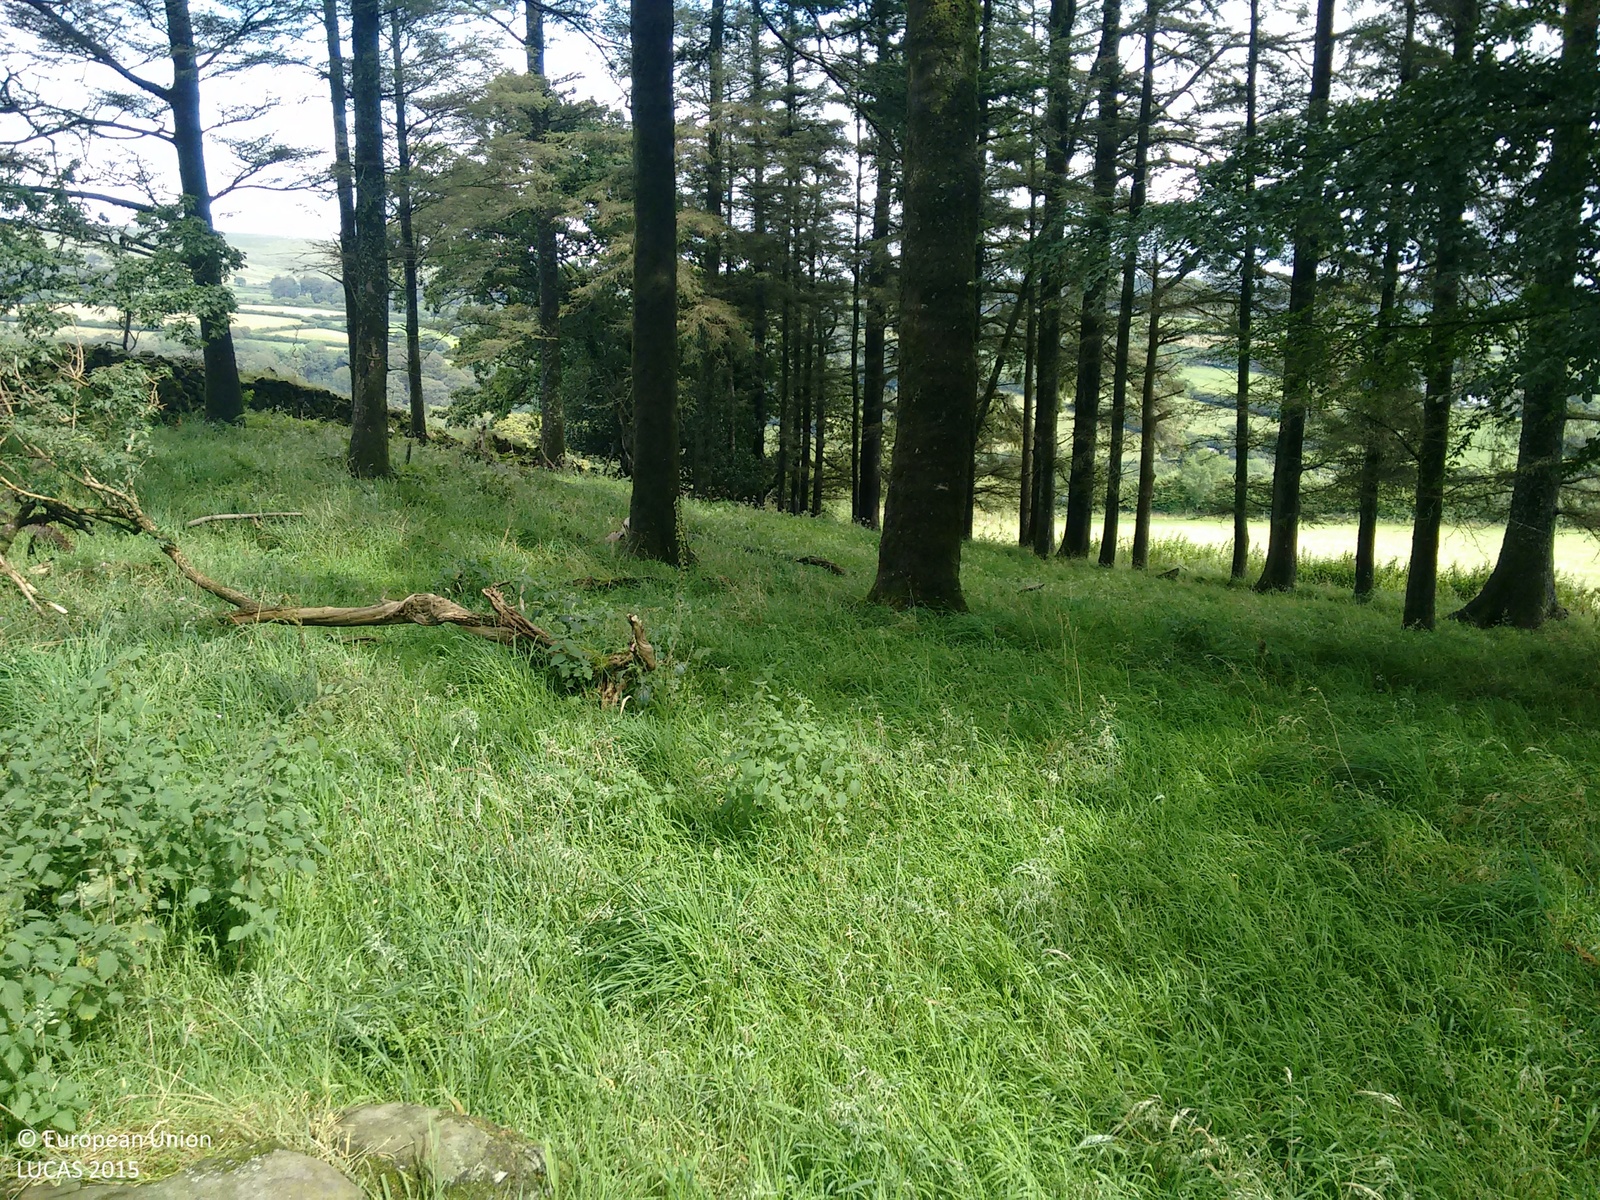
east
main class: Woodland
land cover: Spruce dominated coniferous woodland
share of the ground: > 75 %
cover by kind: coniferous forest trees 100 %
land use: Semi-natural and natural areas not in use
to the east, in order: Spruce dominated coniferous woodland; Fences; Dry stone walls; Fences; Grassland without tree/shrub cover; Fences; Managed hedges; Fences; Grassland without tree/shrub cover
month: August
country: GB
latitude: 50.4335
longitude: -3.9601
